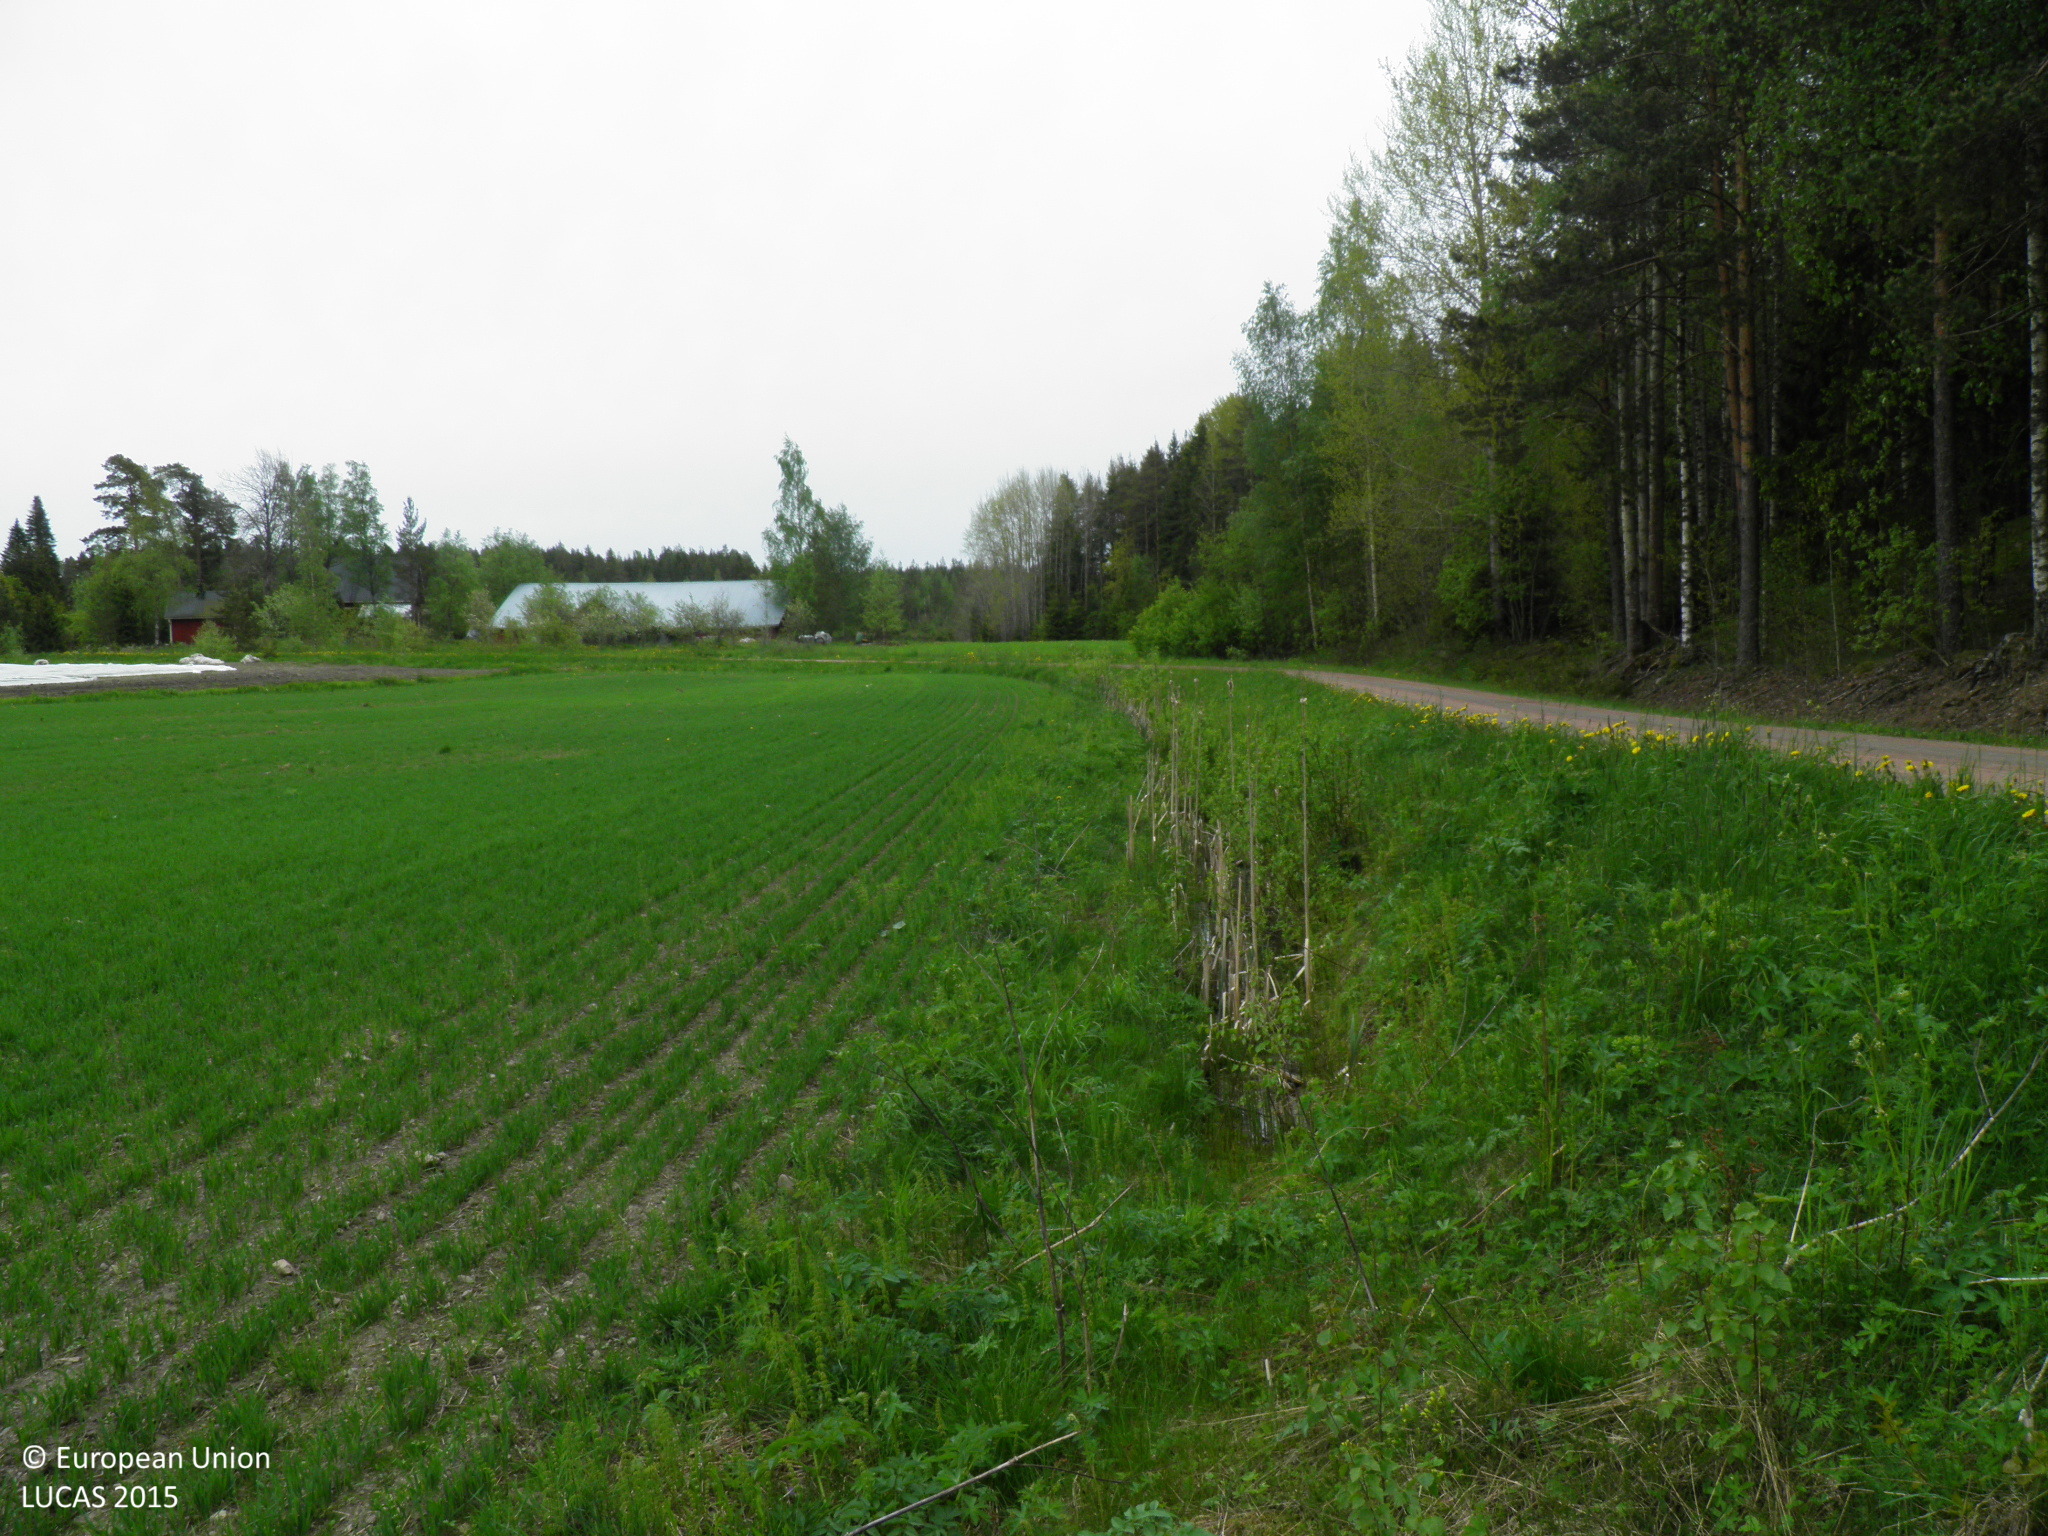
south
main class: Cropland
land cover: Oats
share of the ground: 50 - 75 %
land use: Agriculture (excluding fallow land and kitchen gardens)
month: June
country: FI
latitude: 60.5031
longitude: 22.6538
